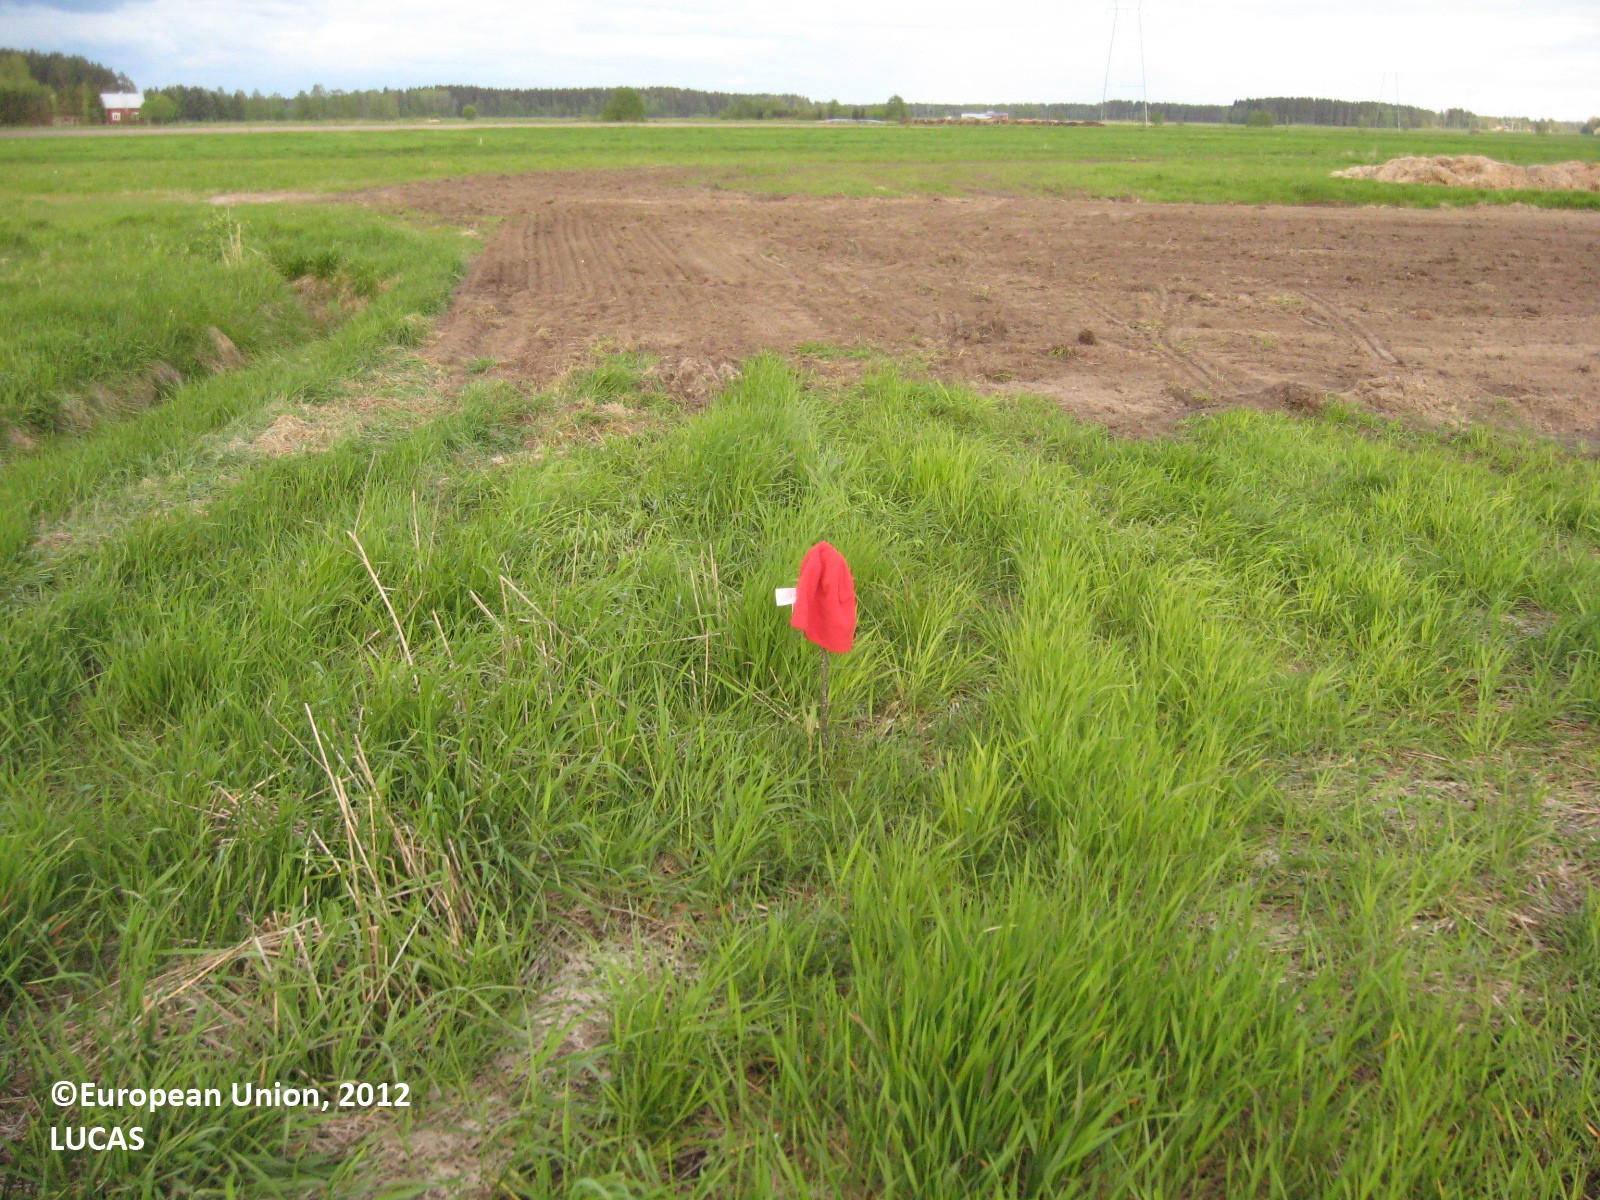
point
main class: Grassland
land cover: Grassland without tree/shrub cover
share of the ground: > 75 %
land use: Agriculture (excluding fallow land and kitchen gardens)
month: June
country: FI
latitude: 63.3263
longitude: 22.8118
